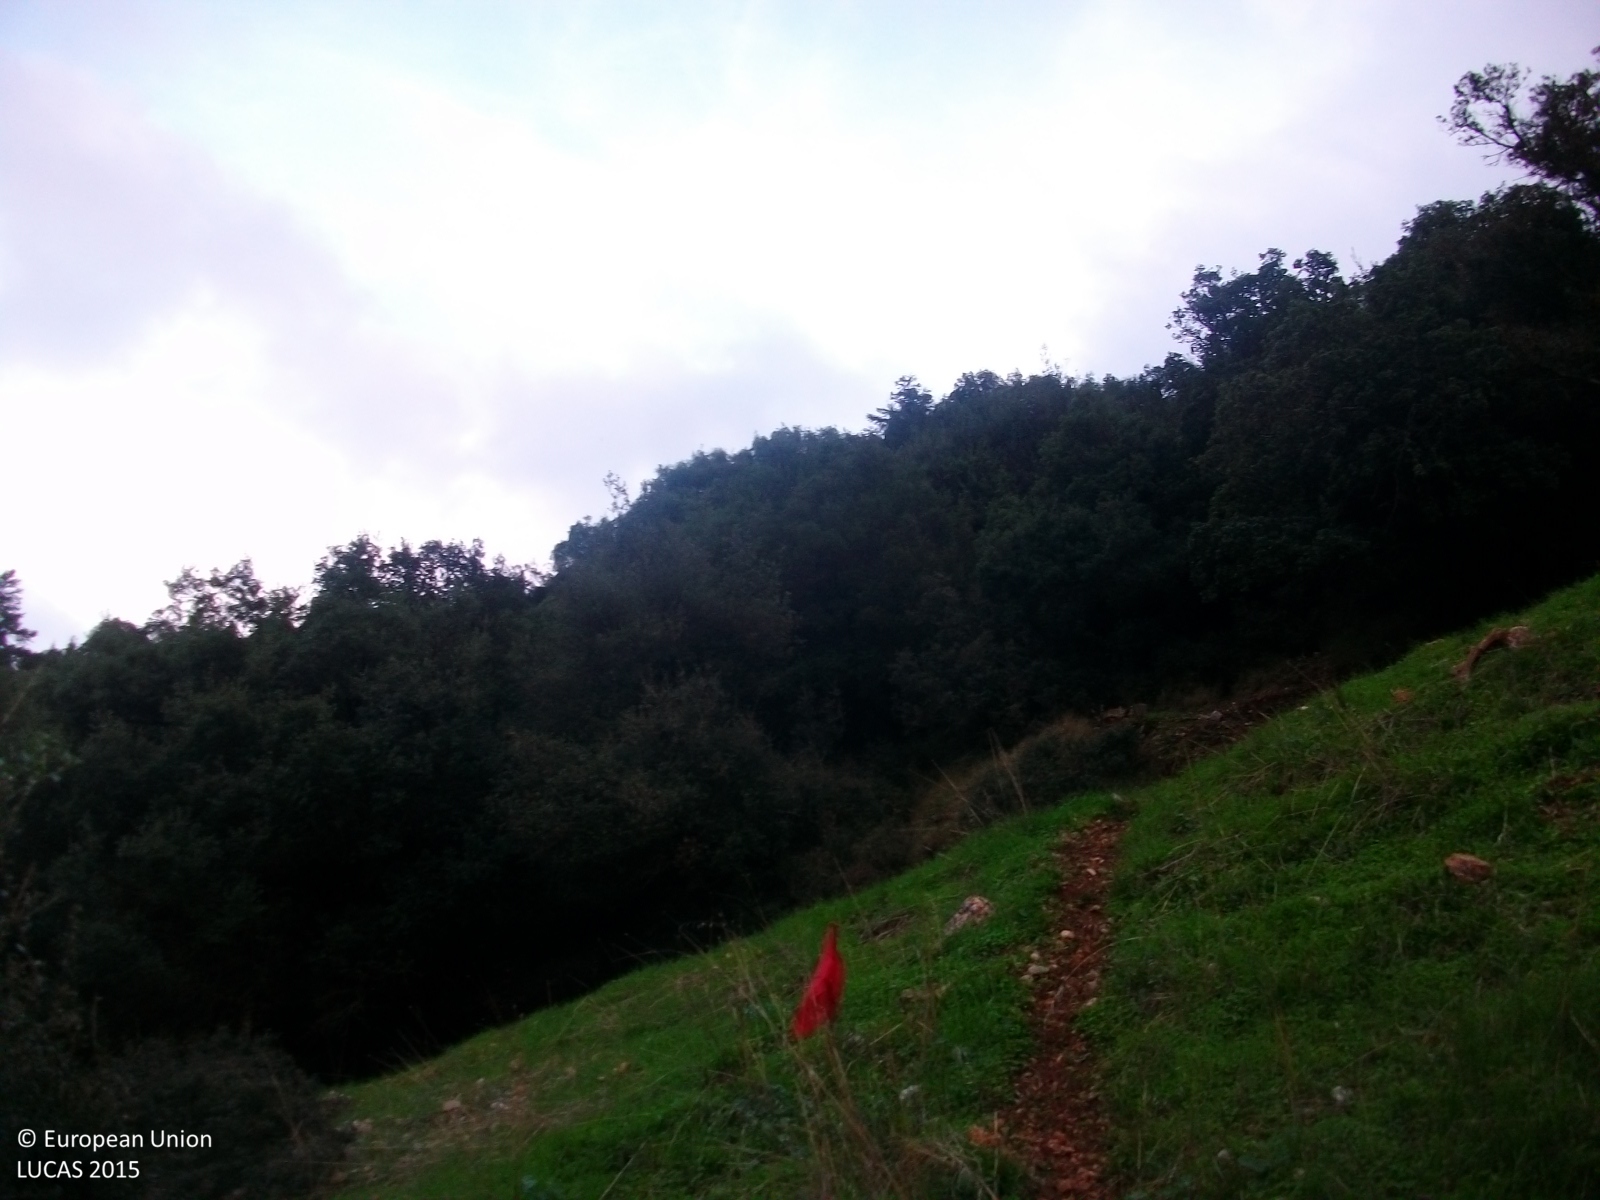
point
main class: Shrubland
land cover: Shrubland with sparse tree cover
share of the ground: 50 - 75 %
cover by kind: shrubs 50 %, herbaceous plants 40 %, broadleaved forest trees 5 %, unconsolidated bare surface 5 %
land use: Semi-natural and natural areas not in use
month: October
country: GR
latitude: 37.8502
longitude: 22.3884
